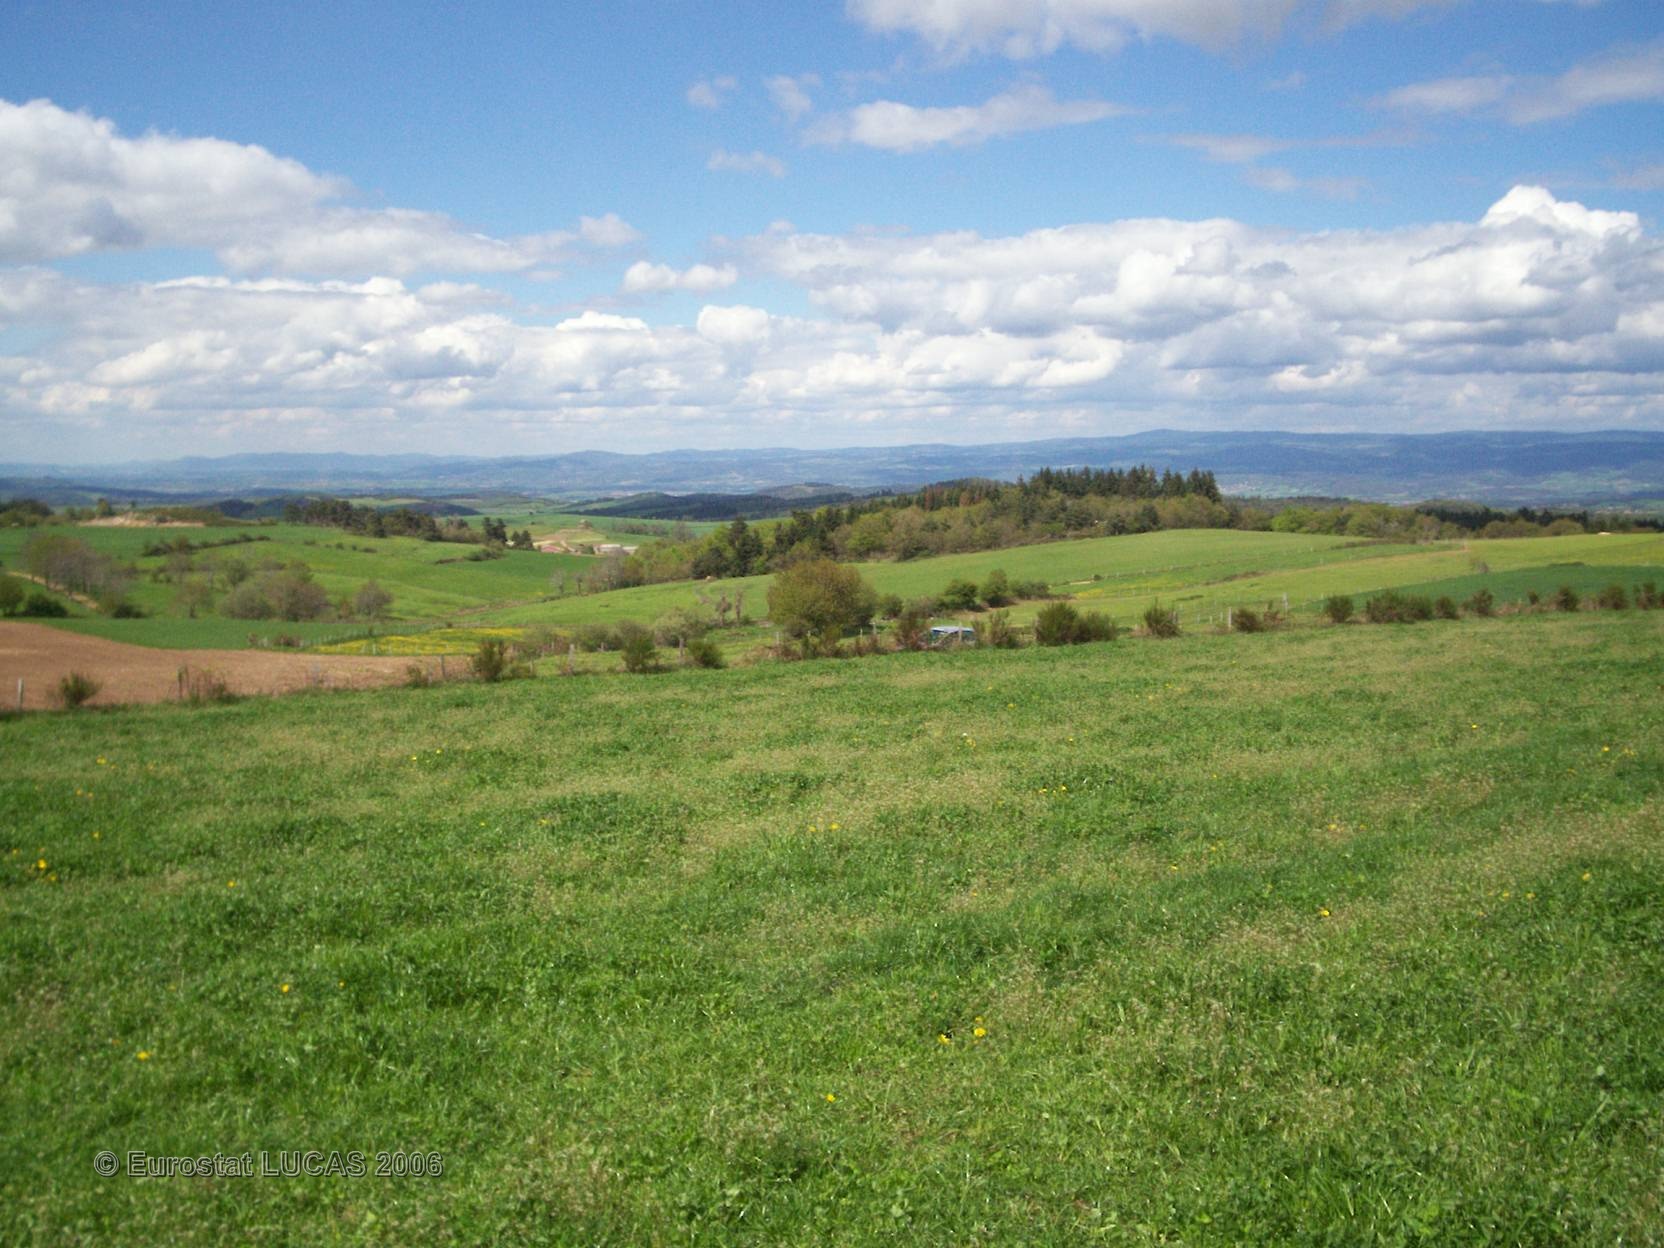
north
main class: Grassland
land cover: Grassland without tree/shrub cover
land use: Agriculture (excluding fallow land and kitchen gardens)
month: May
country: FR
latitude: 45.1859
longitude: 3.3462
